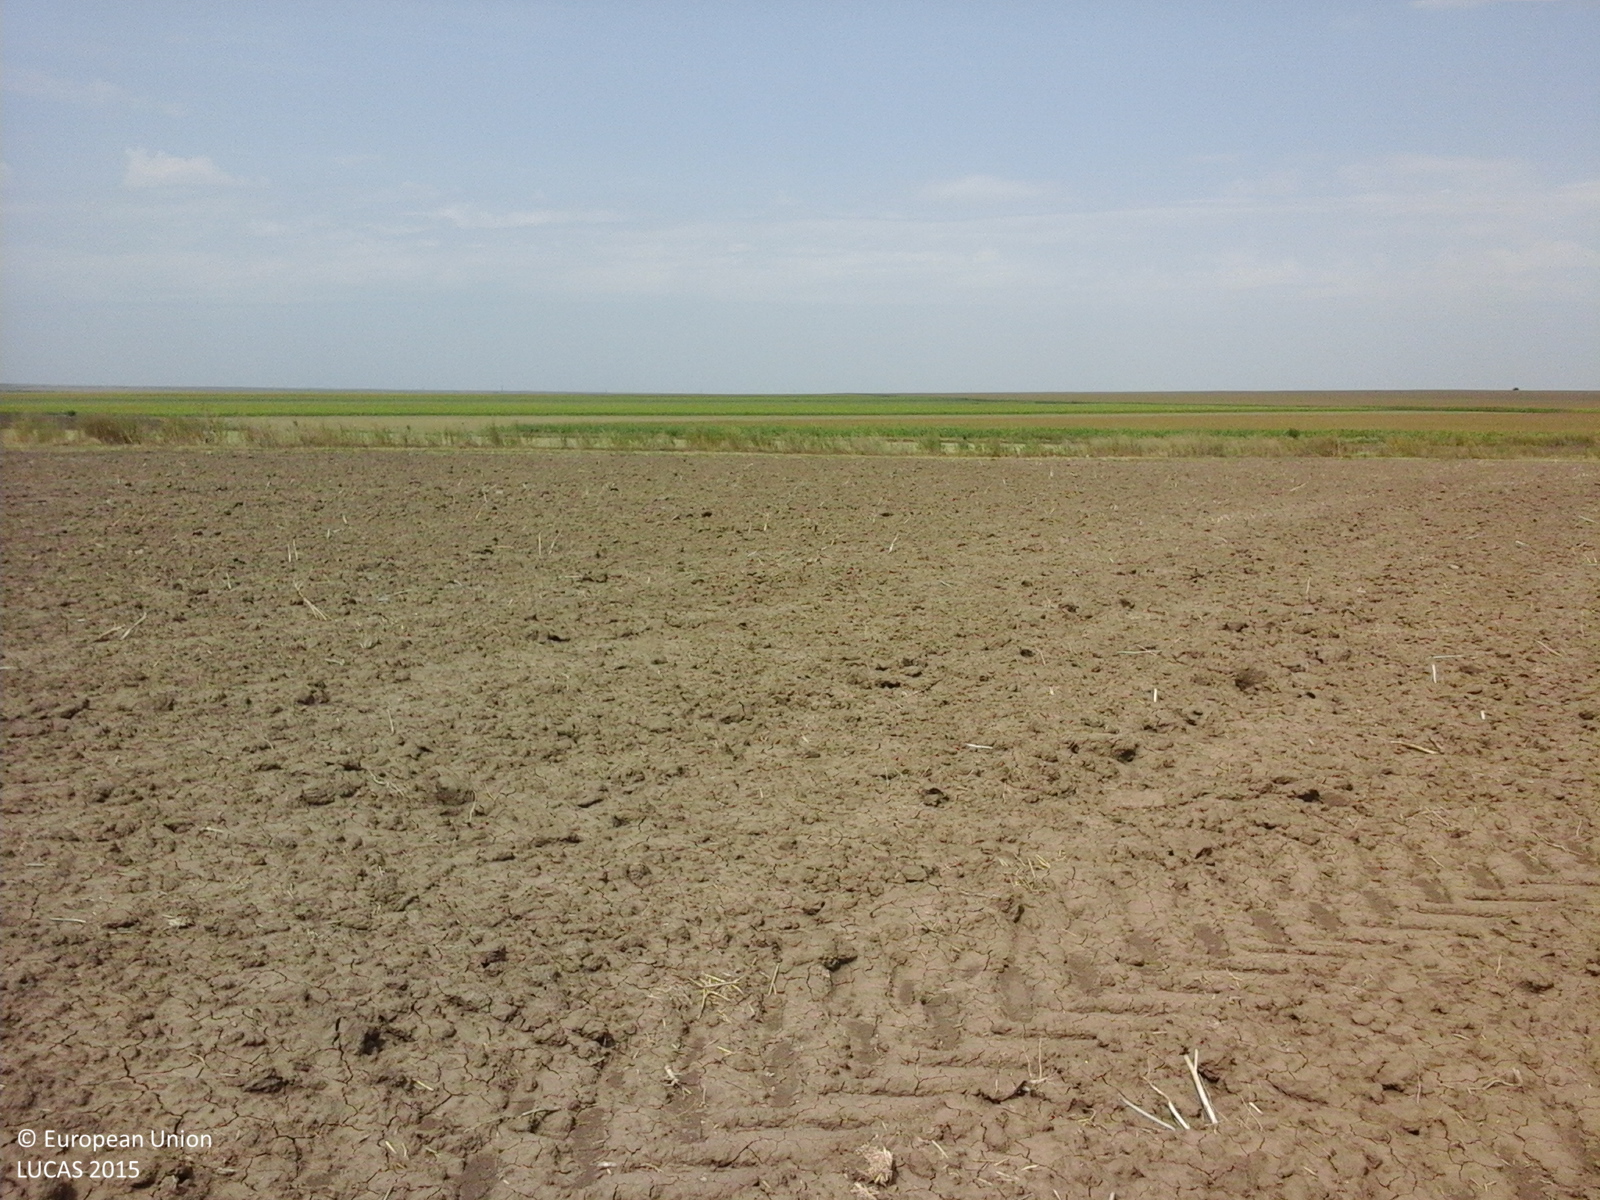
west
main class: Cropland
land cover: Rape and turnip rape
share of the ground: < 10 %
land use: Agriculture (excluding fallow land and kitchen gardens)
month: August
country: RO
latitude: 43.9796
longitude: 28.4028
